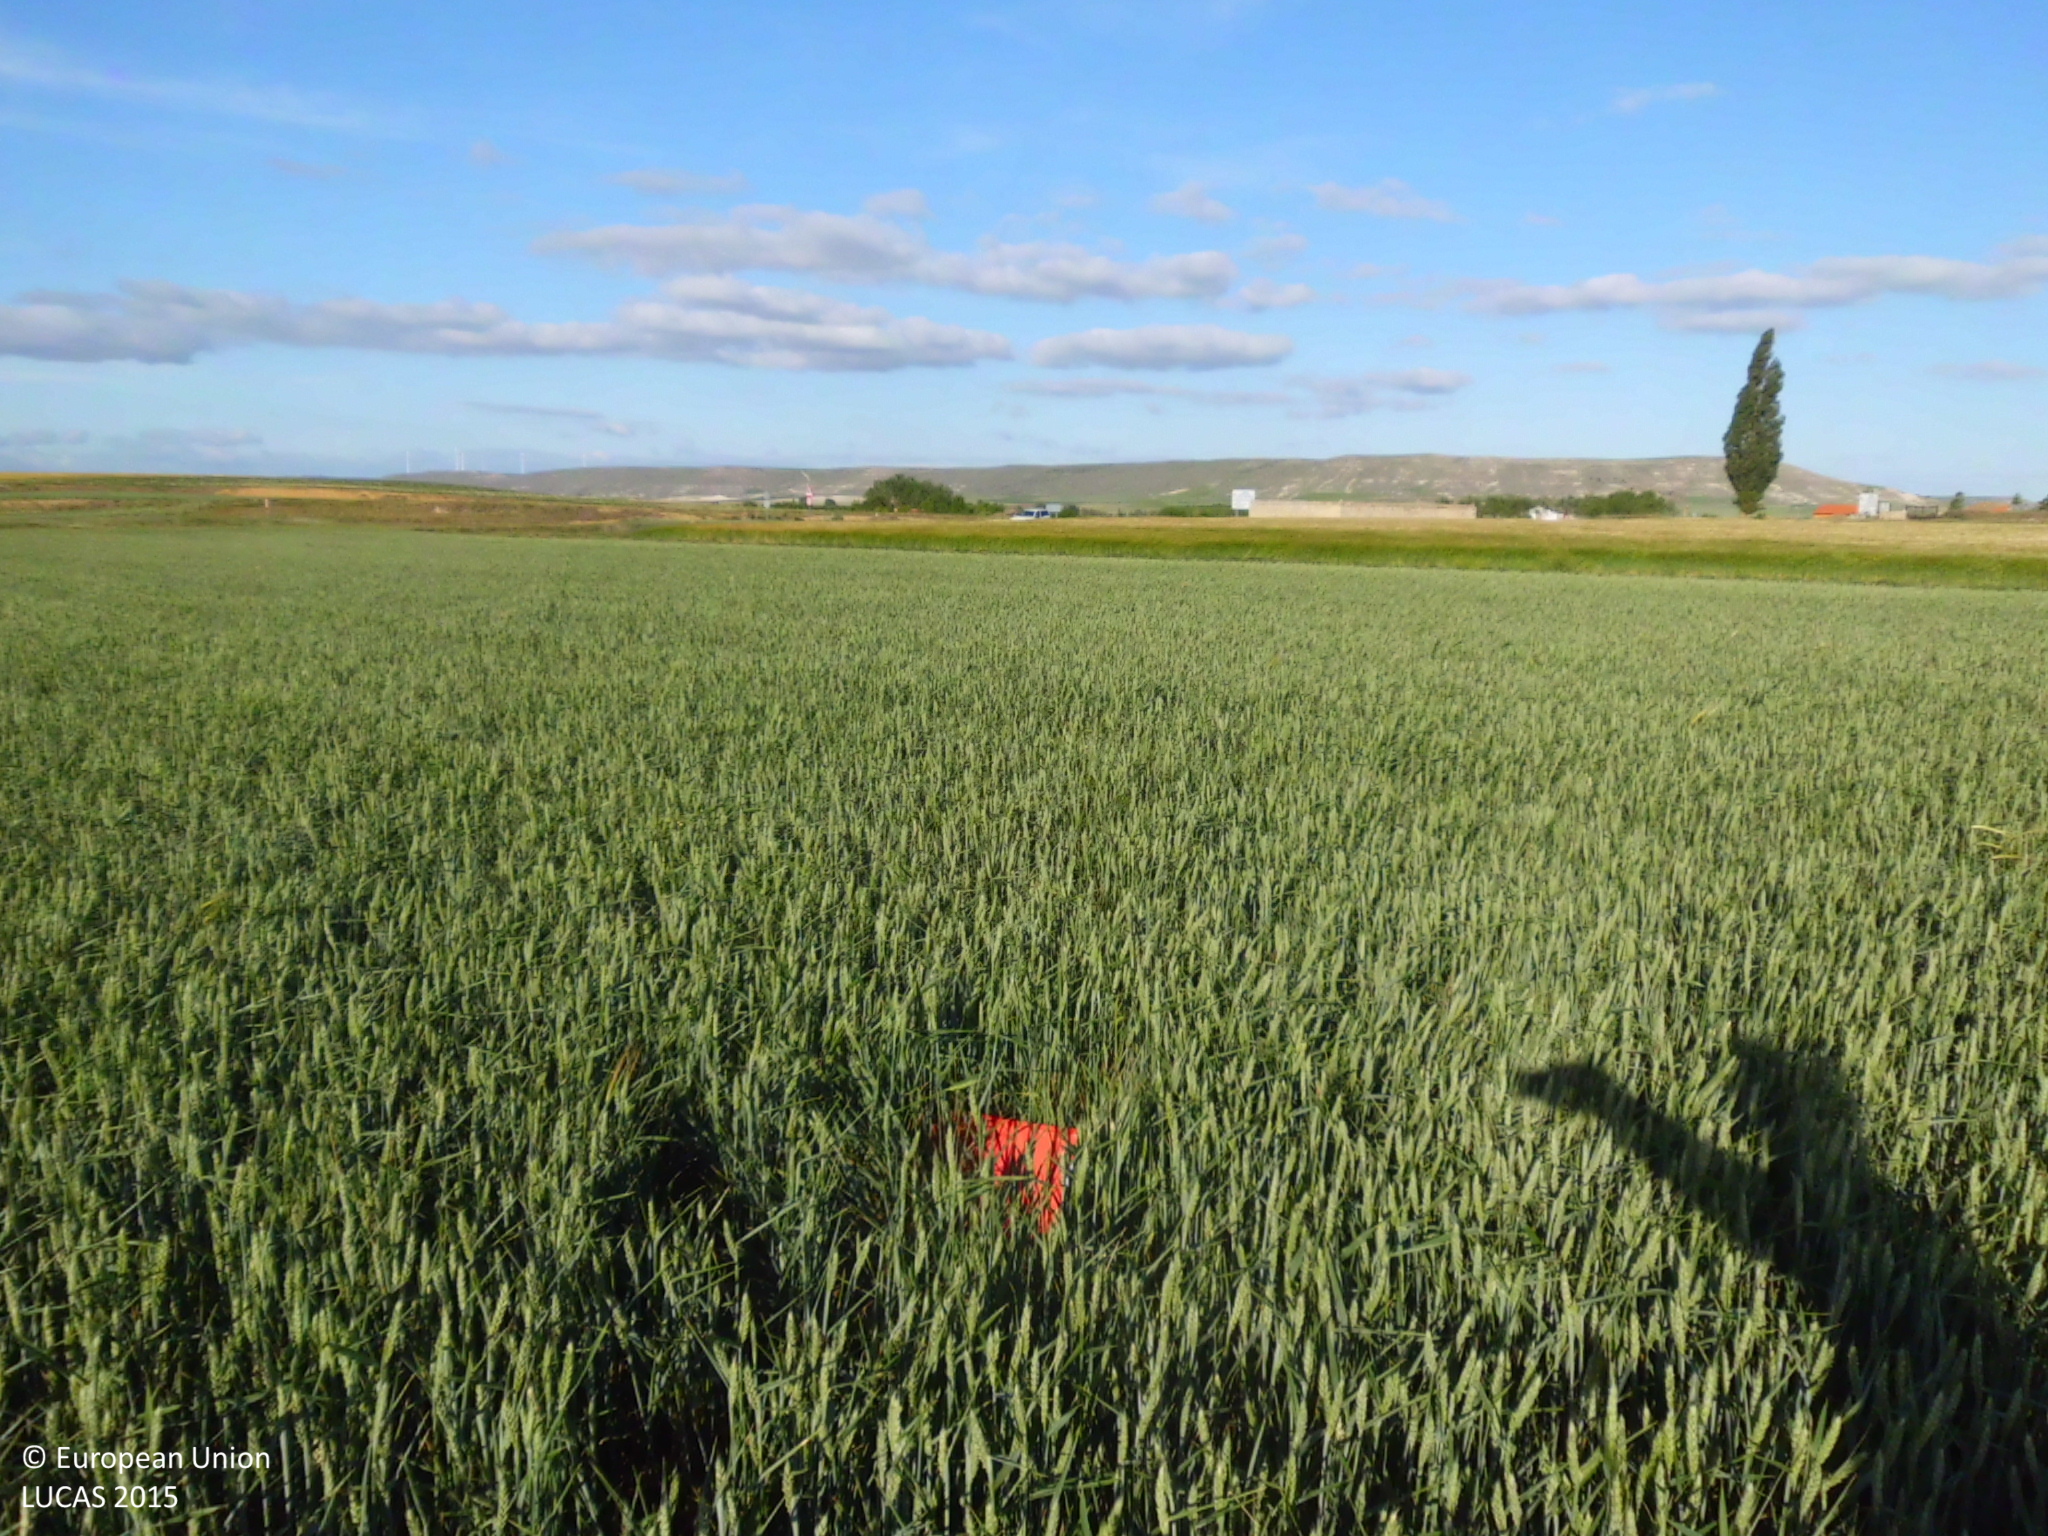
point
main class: Cropland
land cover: Common wheat
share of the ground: > 75 %
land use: Agriculture (excluding fallow land and kitchen gardens)
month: May
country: ES
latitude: 42.3101
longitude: -4.1771
